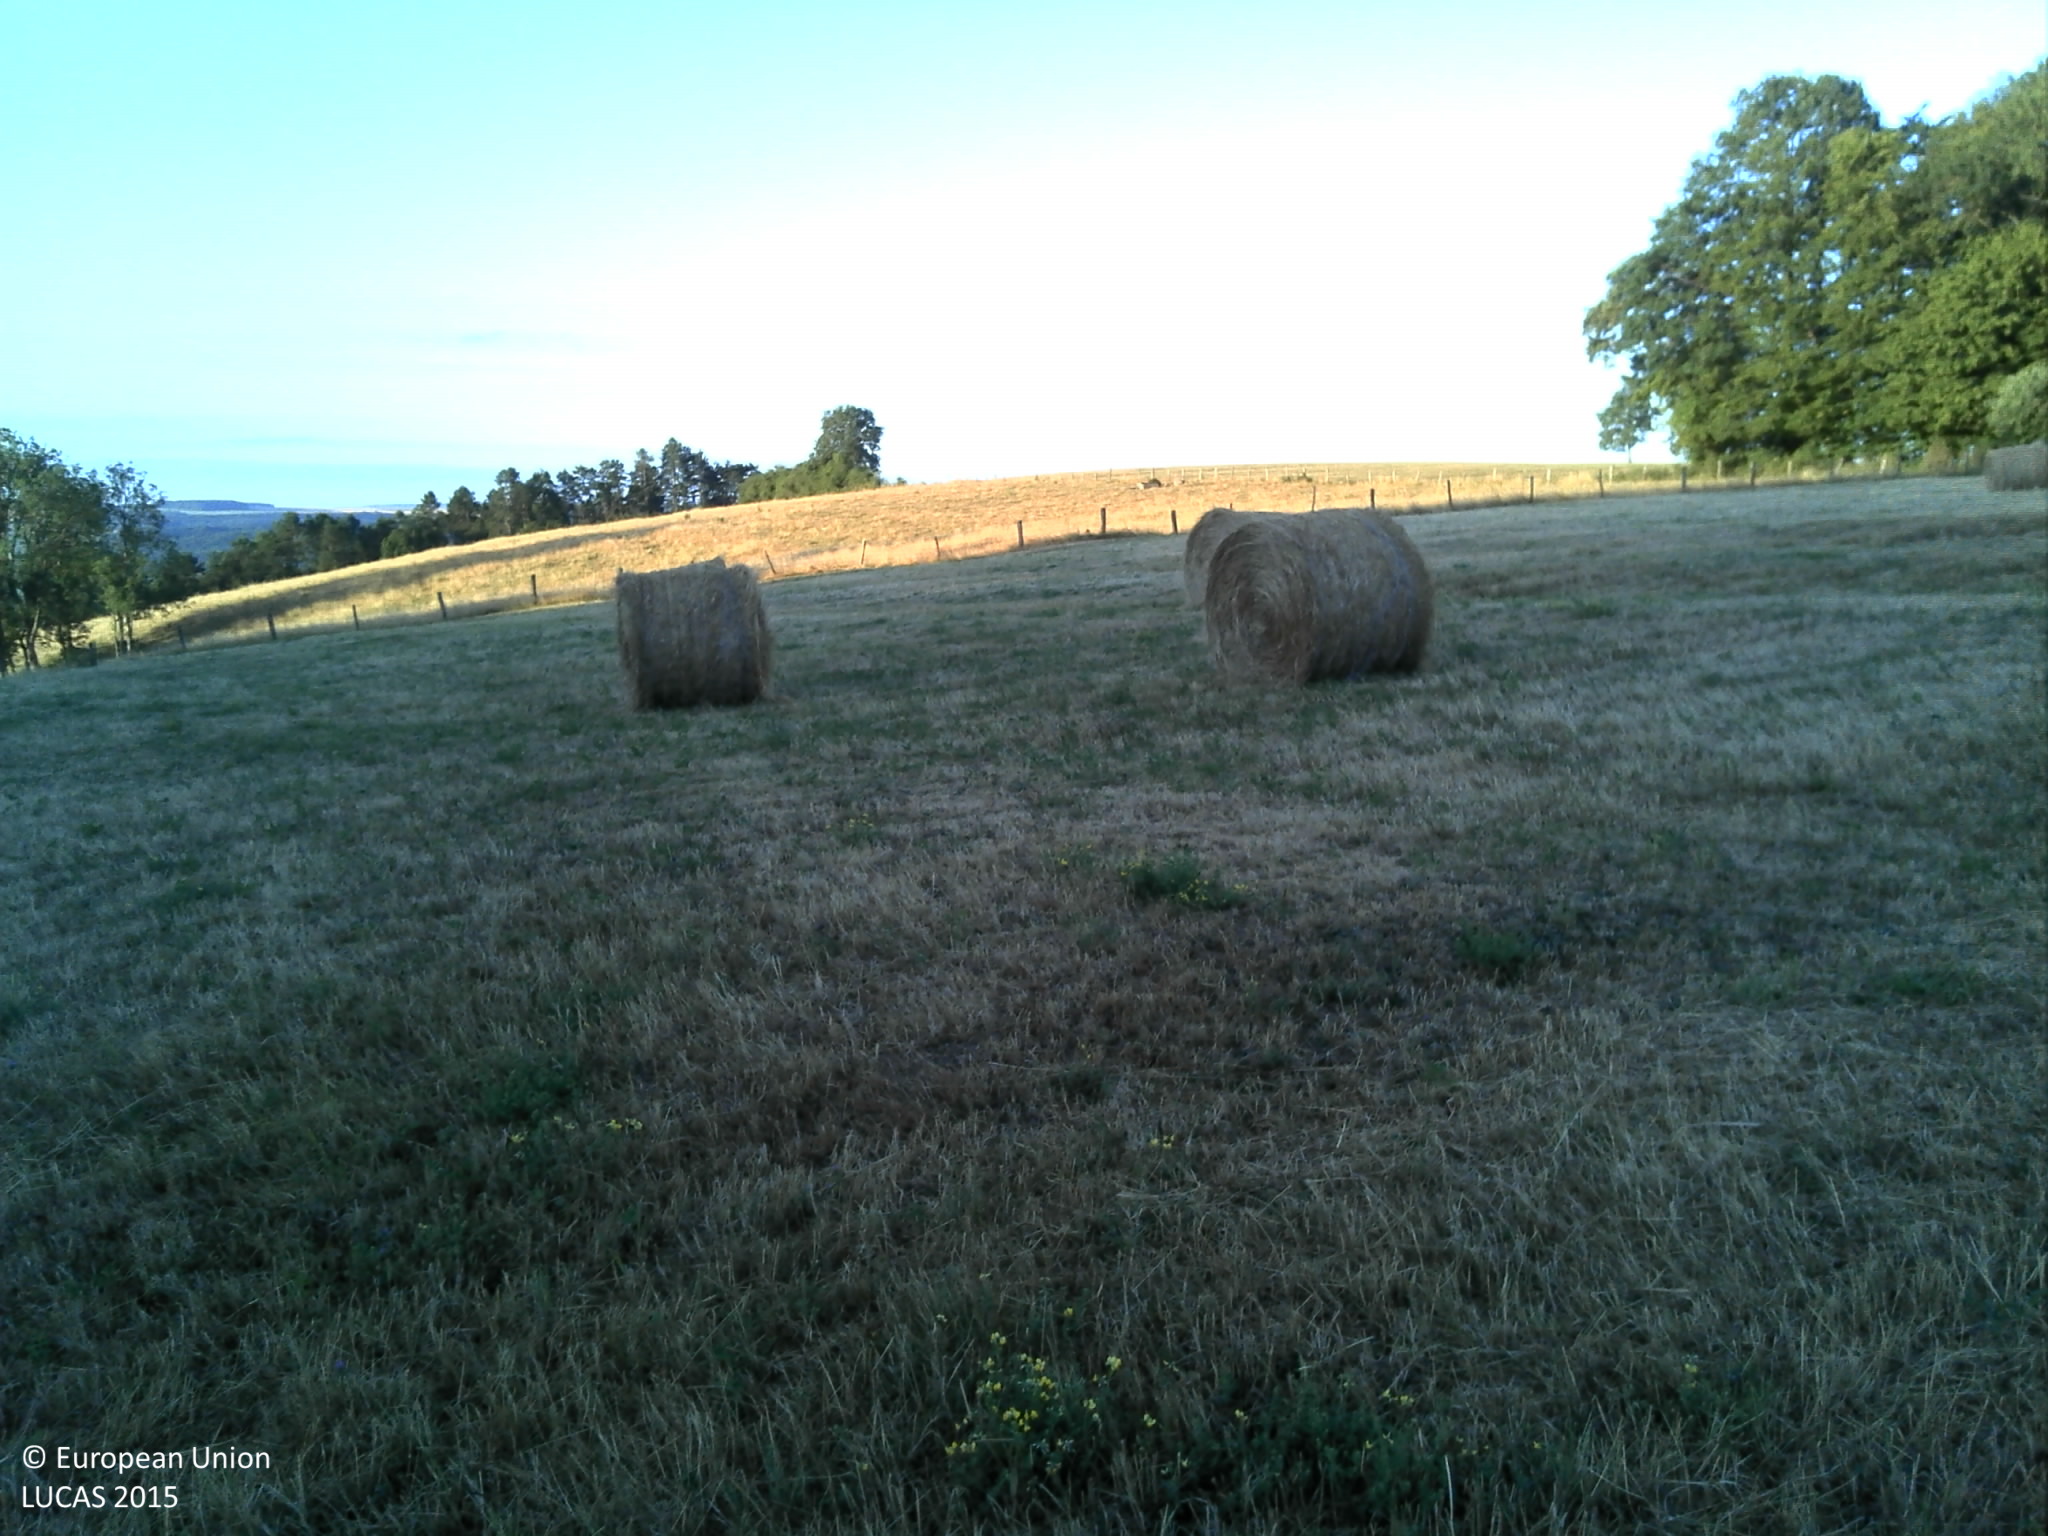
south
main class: Grassland
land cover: Grassland without tree/shrub cover
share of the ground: > 75 %
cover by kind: herbaceous plants 100 %
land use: Agriculture (excluding fallow land and kitchen gardens)
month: July
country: FR
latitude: 48.2657
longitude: 6.1879
